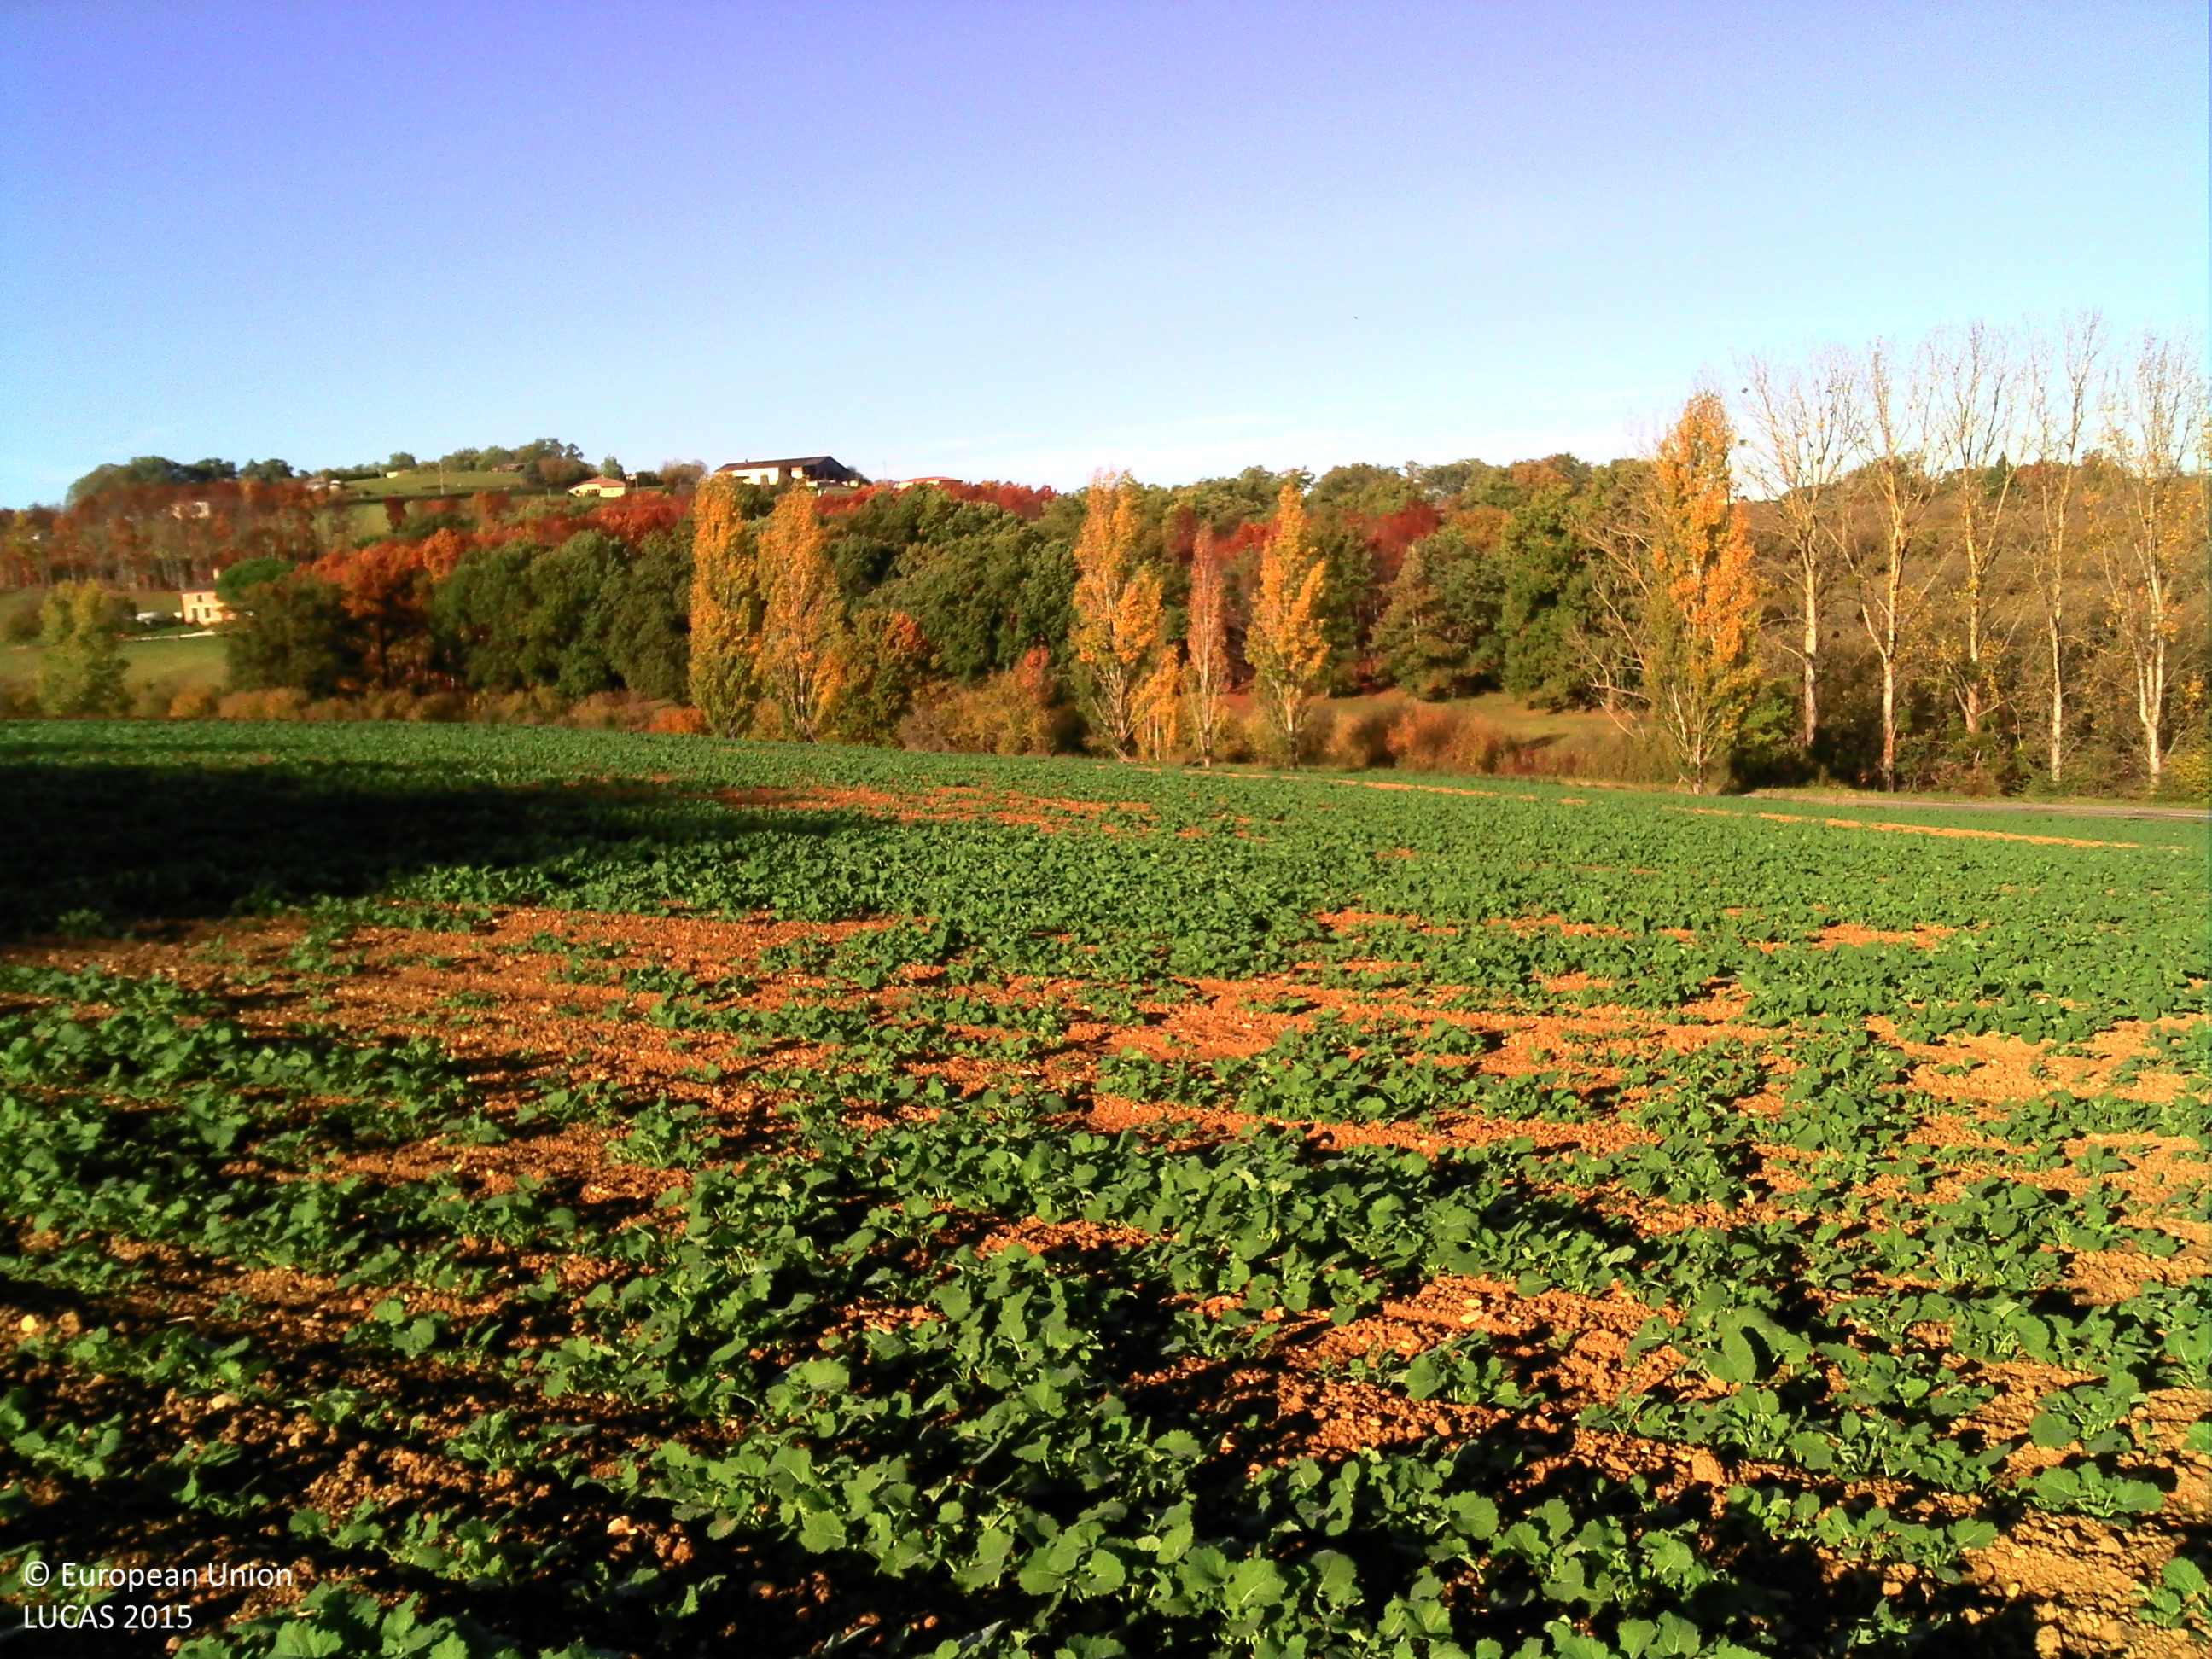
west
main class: Cropland
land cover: Rape and turnip rape
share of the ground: 25 - 50 %
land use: Agriculture (excluding fallow land and kitchen gardens)
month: October
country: FR
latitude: 43.9556
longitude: 0.9635
